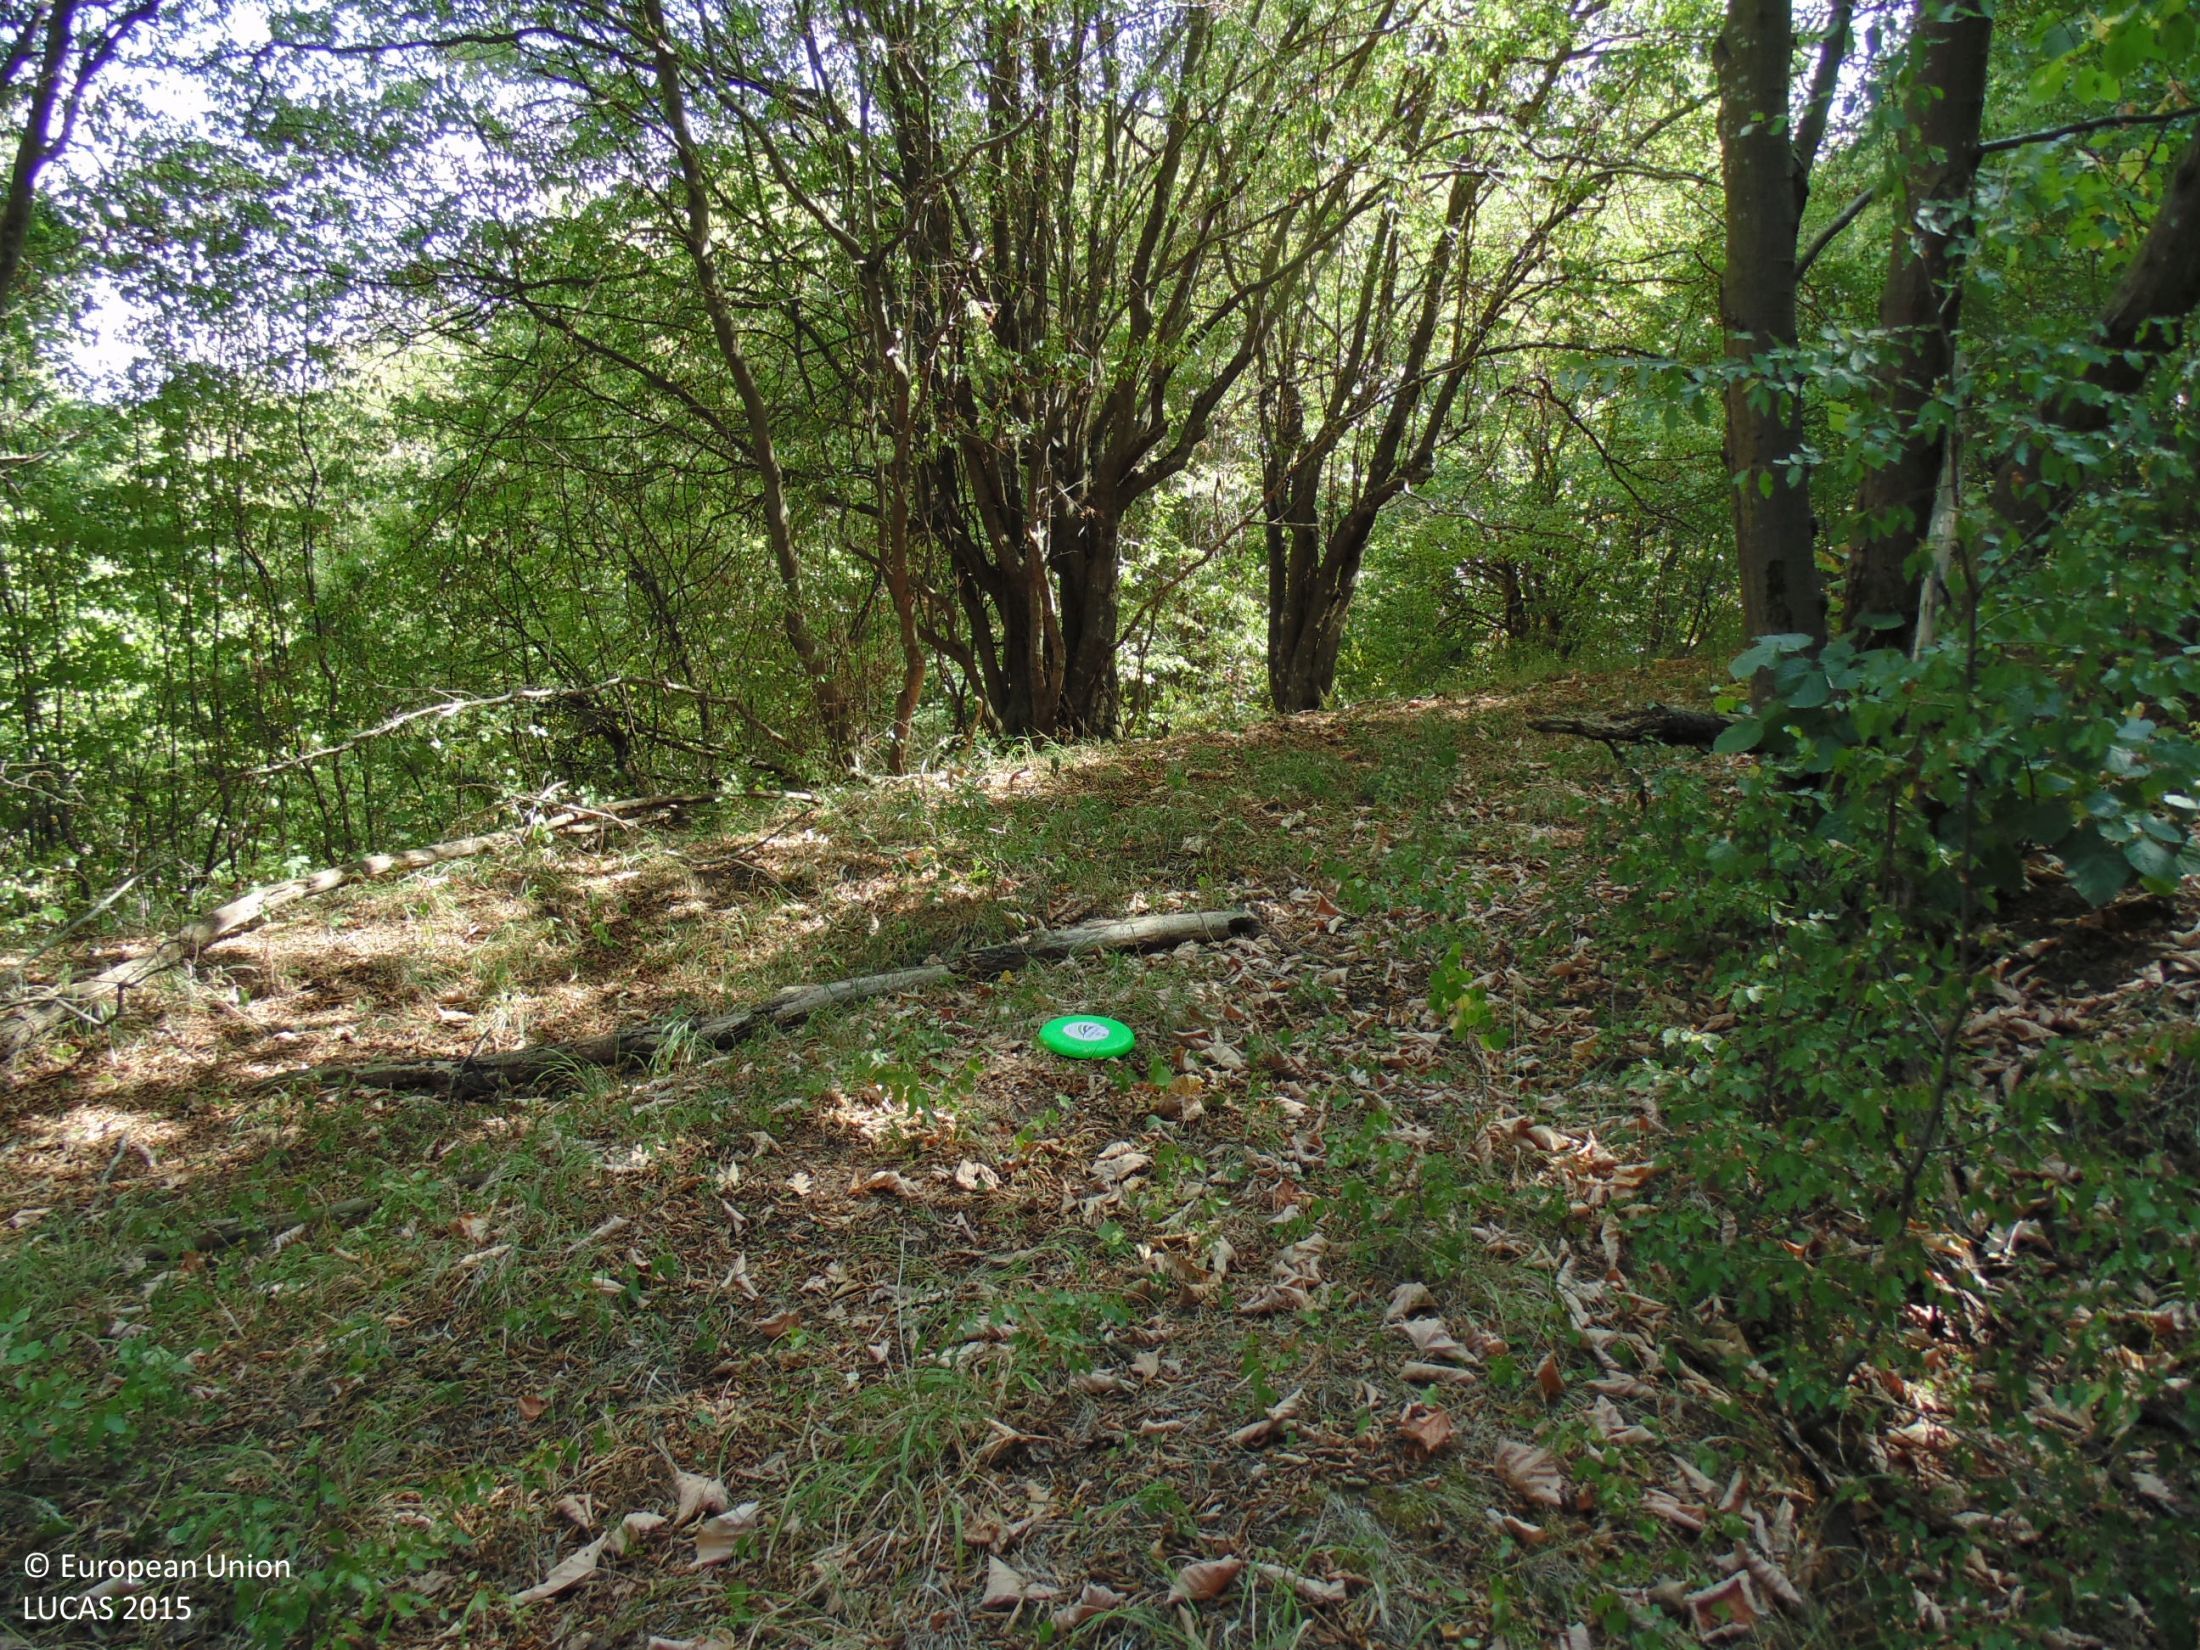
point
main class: Woodland
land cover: Broadleaved woodland
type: mesophytic deciduous forest
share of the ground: > 75 %
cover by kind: broadleaved forest trees 85 %, shrubs 10 %, unconsolidated bare surface 5 %
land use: Forestry
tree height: > 5 m
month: August
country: BG
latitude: 43.8078
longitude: 27.6031
